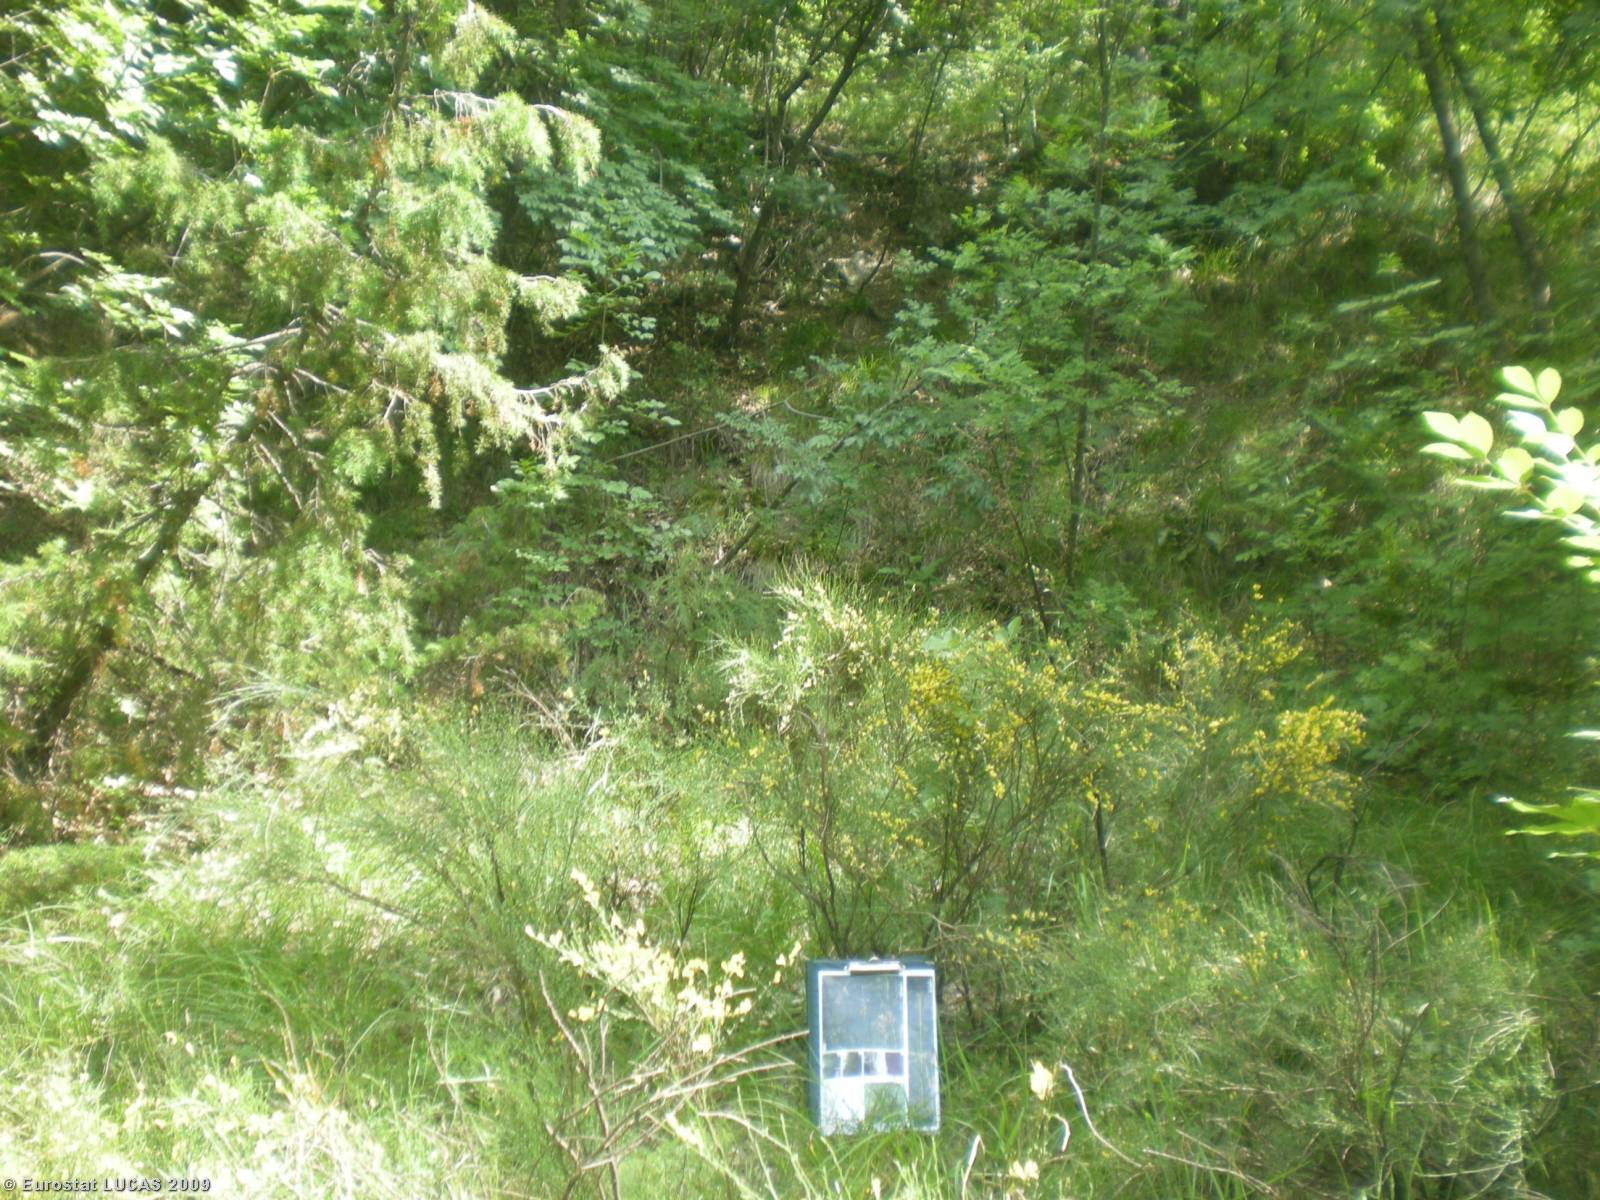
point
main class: Woodland
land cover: Broadleaved woodland
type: mesophytic deciduous forest
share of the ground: > 75 %
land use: Agriculture (excluding fallow land and kitchen gardens)
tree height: > 5 m
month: June
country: IT
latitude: 44.3124
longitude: 7.1851
